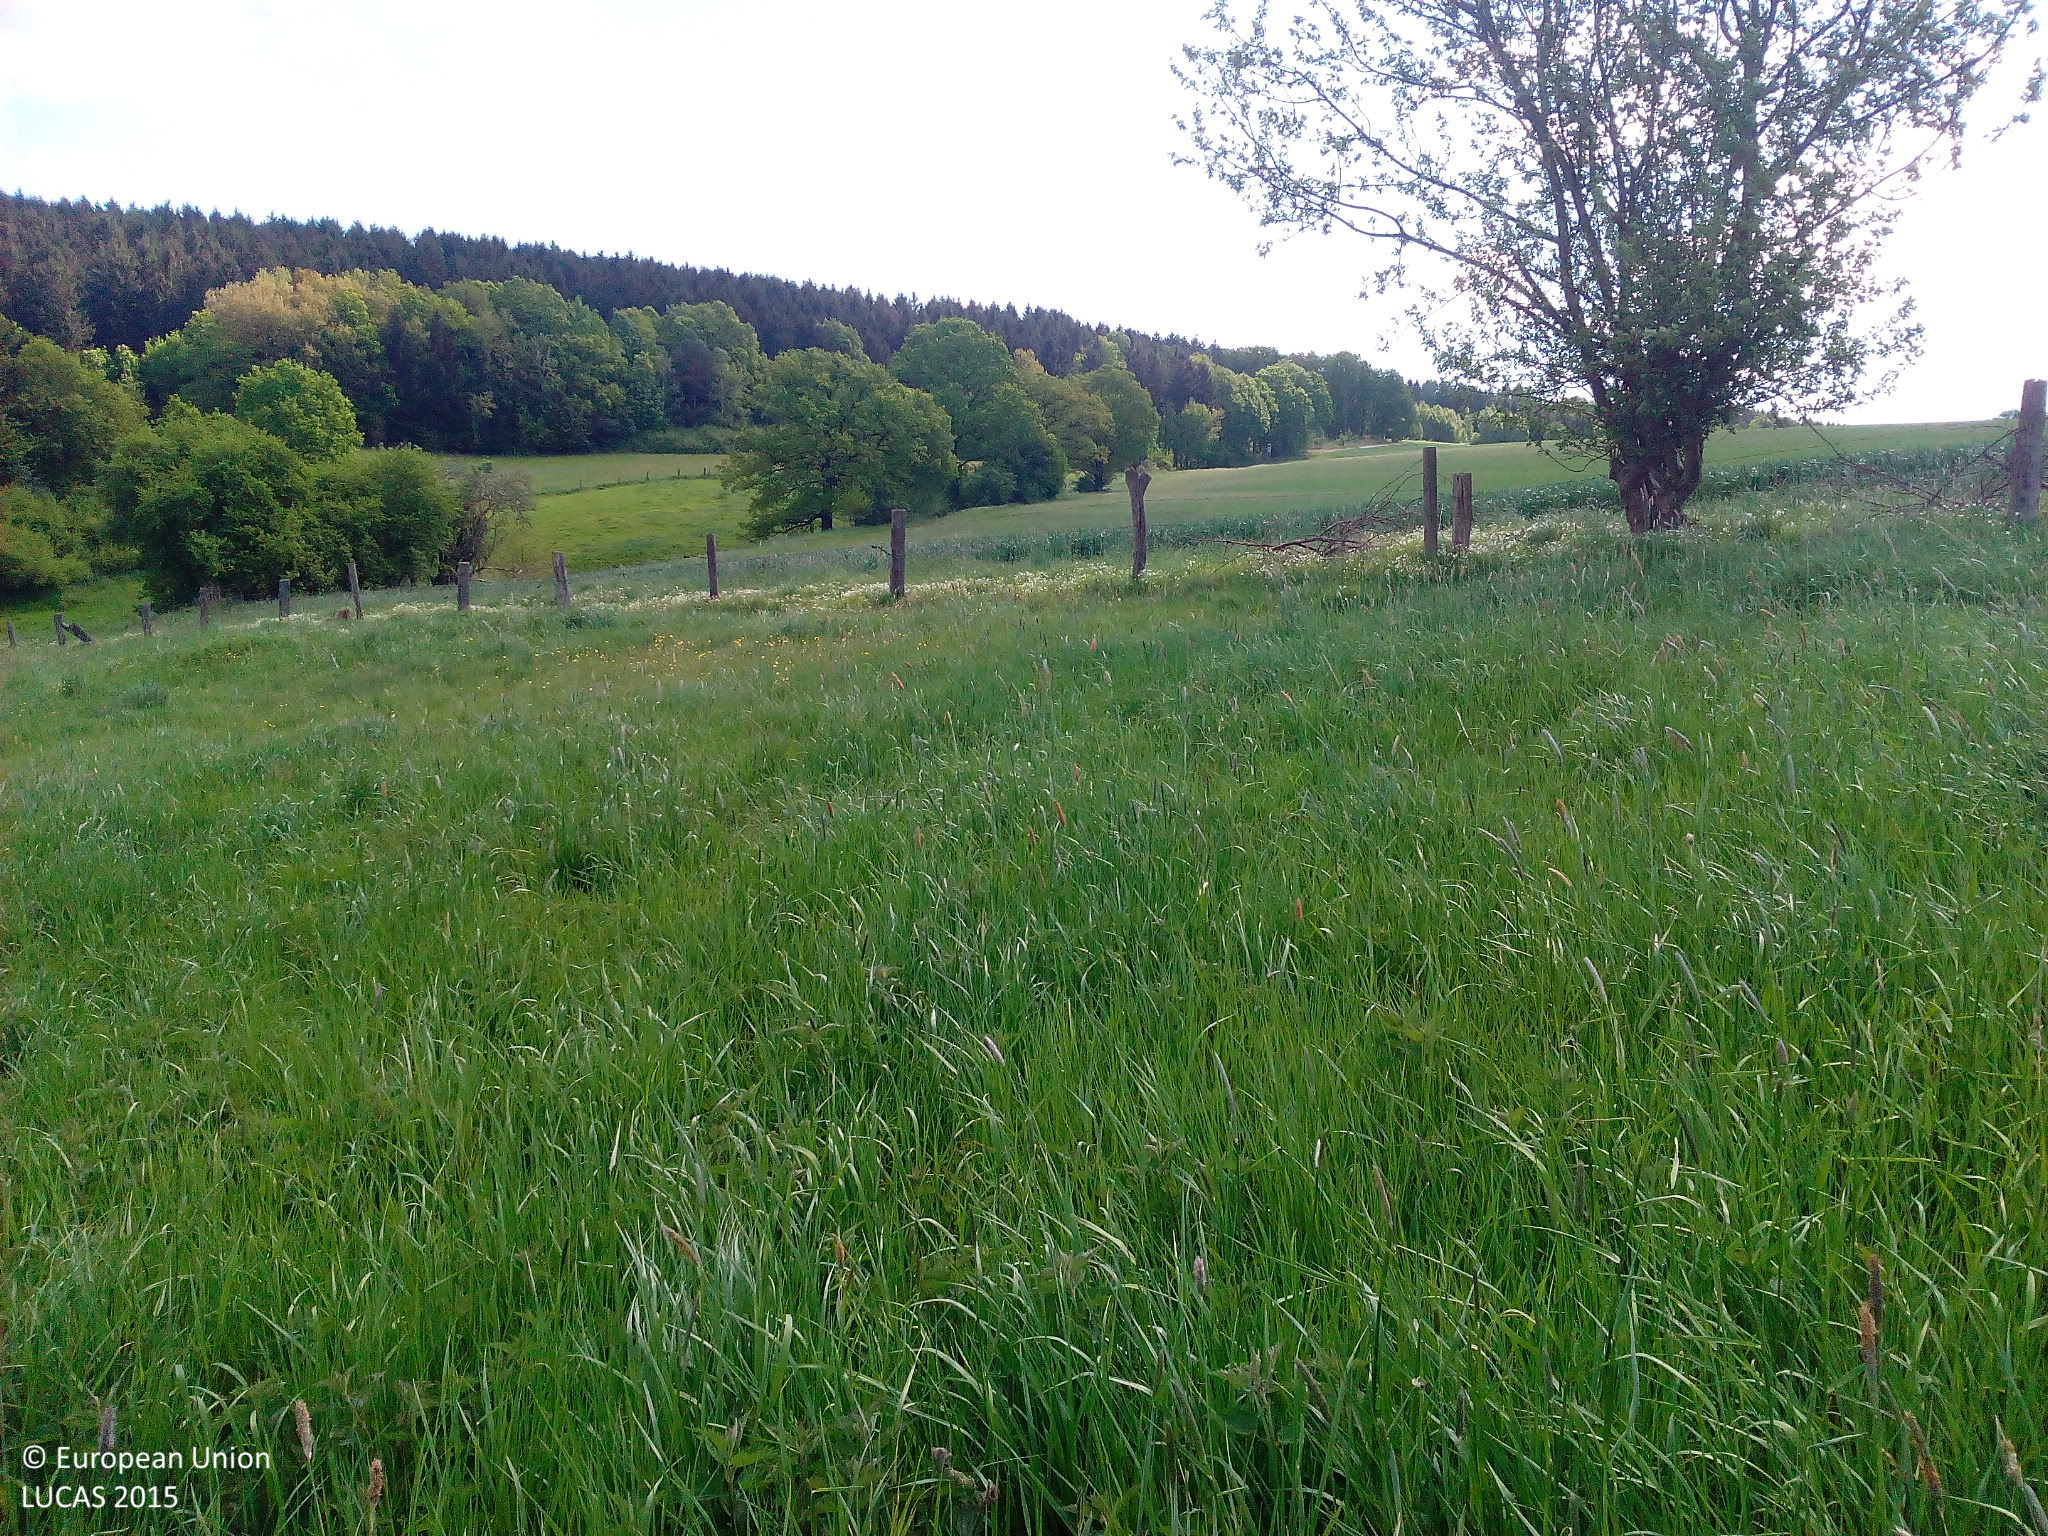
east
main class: Grassland
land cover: Grassland without tree/shrub cover
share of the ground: > 75 %
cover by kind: herbaceous plants 100 %
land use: Agriculture (excluding fallow land and kitchen gardens)
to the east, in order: Grassland without tree/shrub cover; Fences; Single bushes/trees; Grass margins; Tracks; Grass margins; Common wheat; Grass margins; Tracks; Grassland without tree/shrub cover; Tracks; Grass margins; Broadleaved woodland; Fences; Grassland without tree/shrub cover; Fences; Grassland without tree/shrub cover
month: May
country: DE
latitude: 51.3344
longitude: 9.6413
